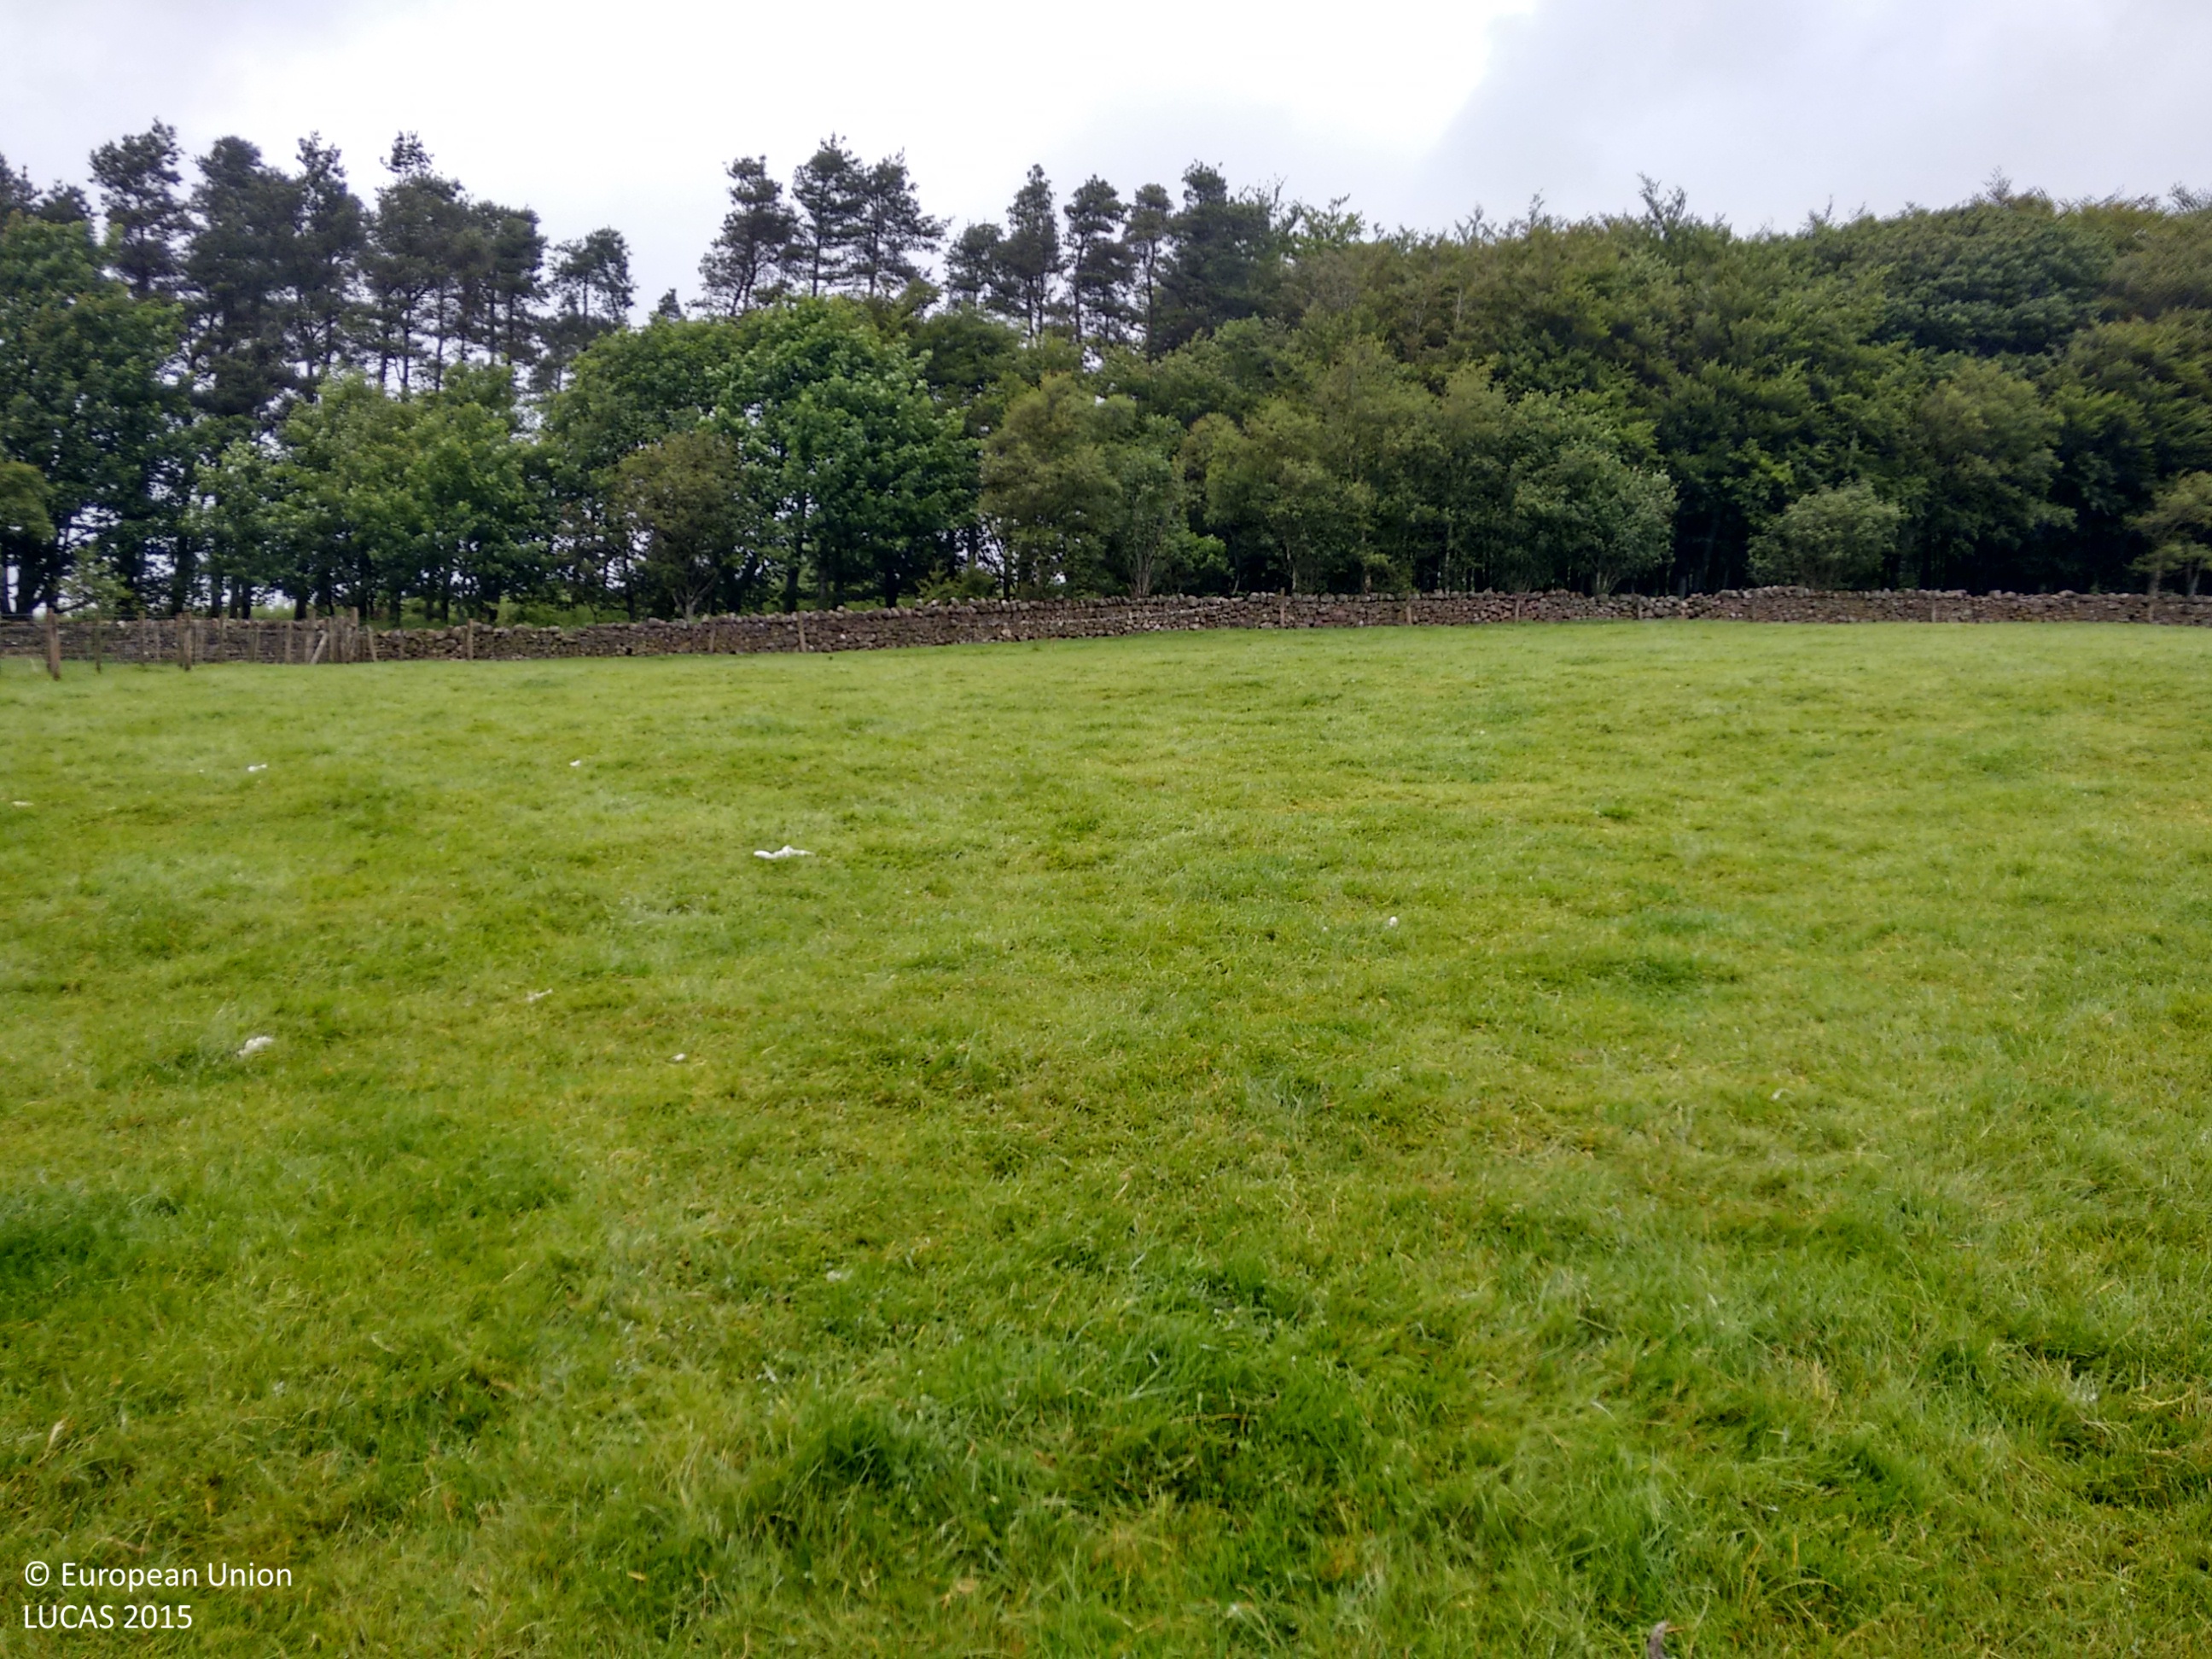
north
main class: Grassland
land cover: Grassland without tree/shrub cover
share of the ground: > 75 %
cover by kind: herbaceous plants 100 %
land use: Agriculture (excluding fallow land and kitchen gardens)
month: June
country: GB
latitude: 55.0353
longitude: -3.2981
